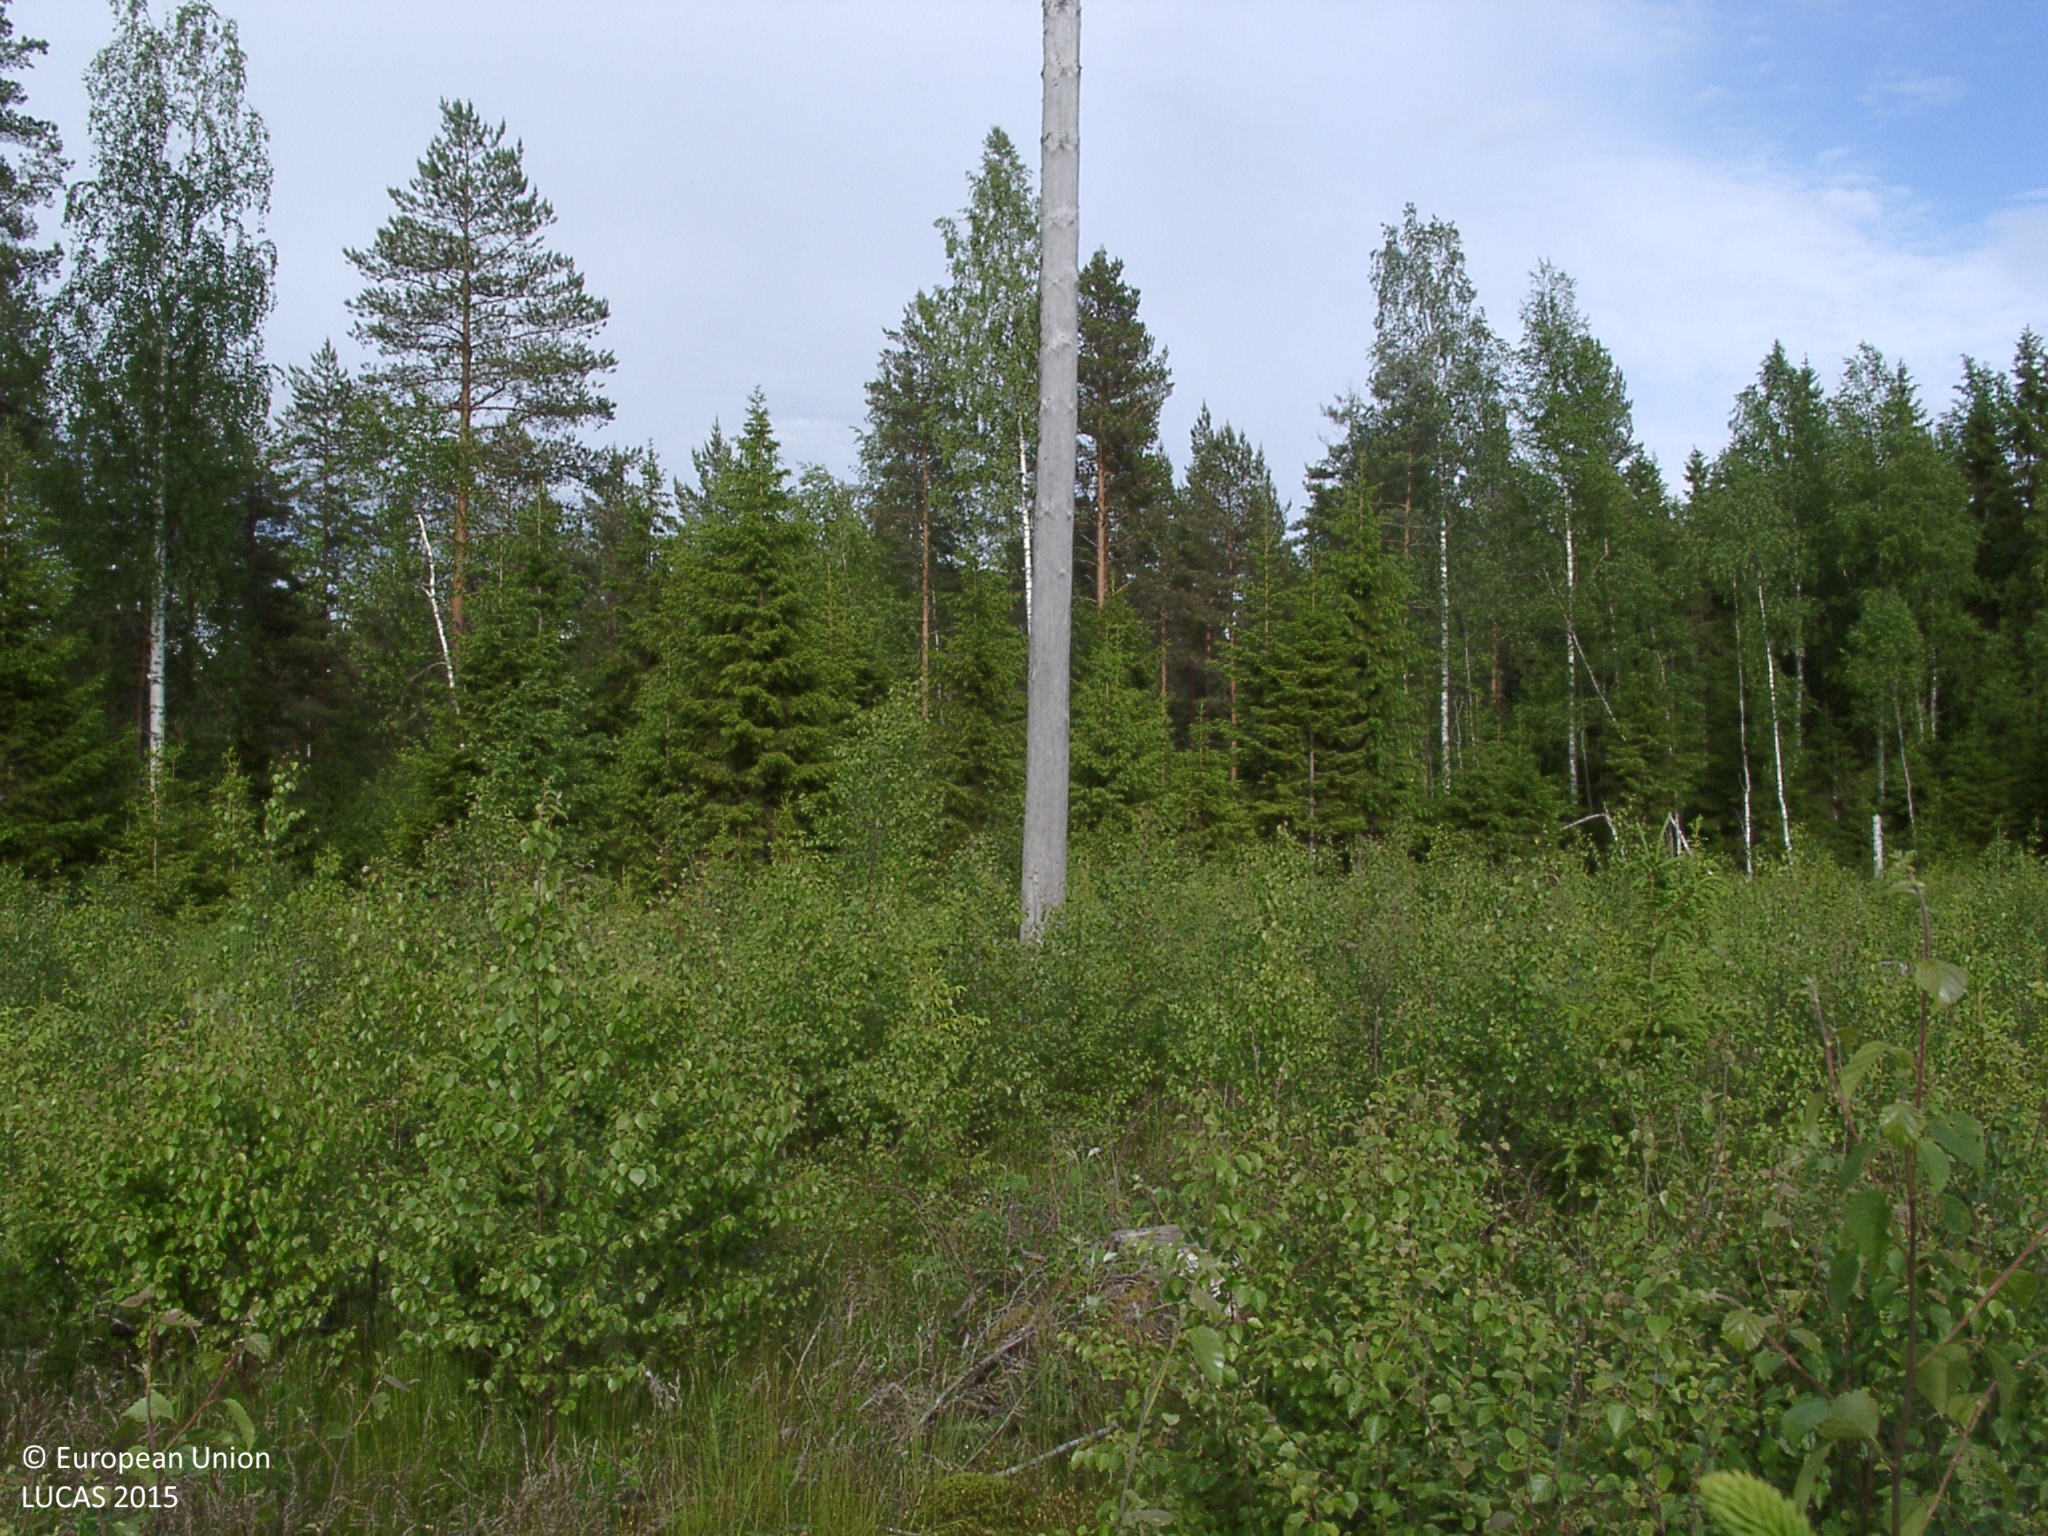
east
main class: Woodland
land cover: Broadleaved woodland
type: non-riverine alder, birch or aspen forest
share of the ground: 25 - 50 %
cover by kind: broadleaved forest trees 35 %, shrubs 25 %, herbaceous plants 25 %, coniferous forest trees 10 %, lichens and mosses 5 %
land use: Forestry
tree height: < 5 m
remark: Nursery
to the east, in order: Broadleaved woodland; Groves; Ditches and canals; Other mixed woodland; Ditches and canals; Other mixed woodland; Ditches and canals; Other mixed woodland; Spruce dominated coniferous woodland; Ditches and canals; Spruce dominated coniferous woodland; Ditches and canals; Spruce dominated coniferous woodland
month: June
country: FI
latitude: 61.9314
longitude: 24.7892
